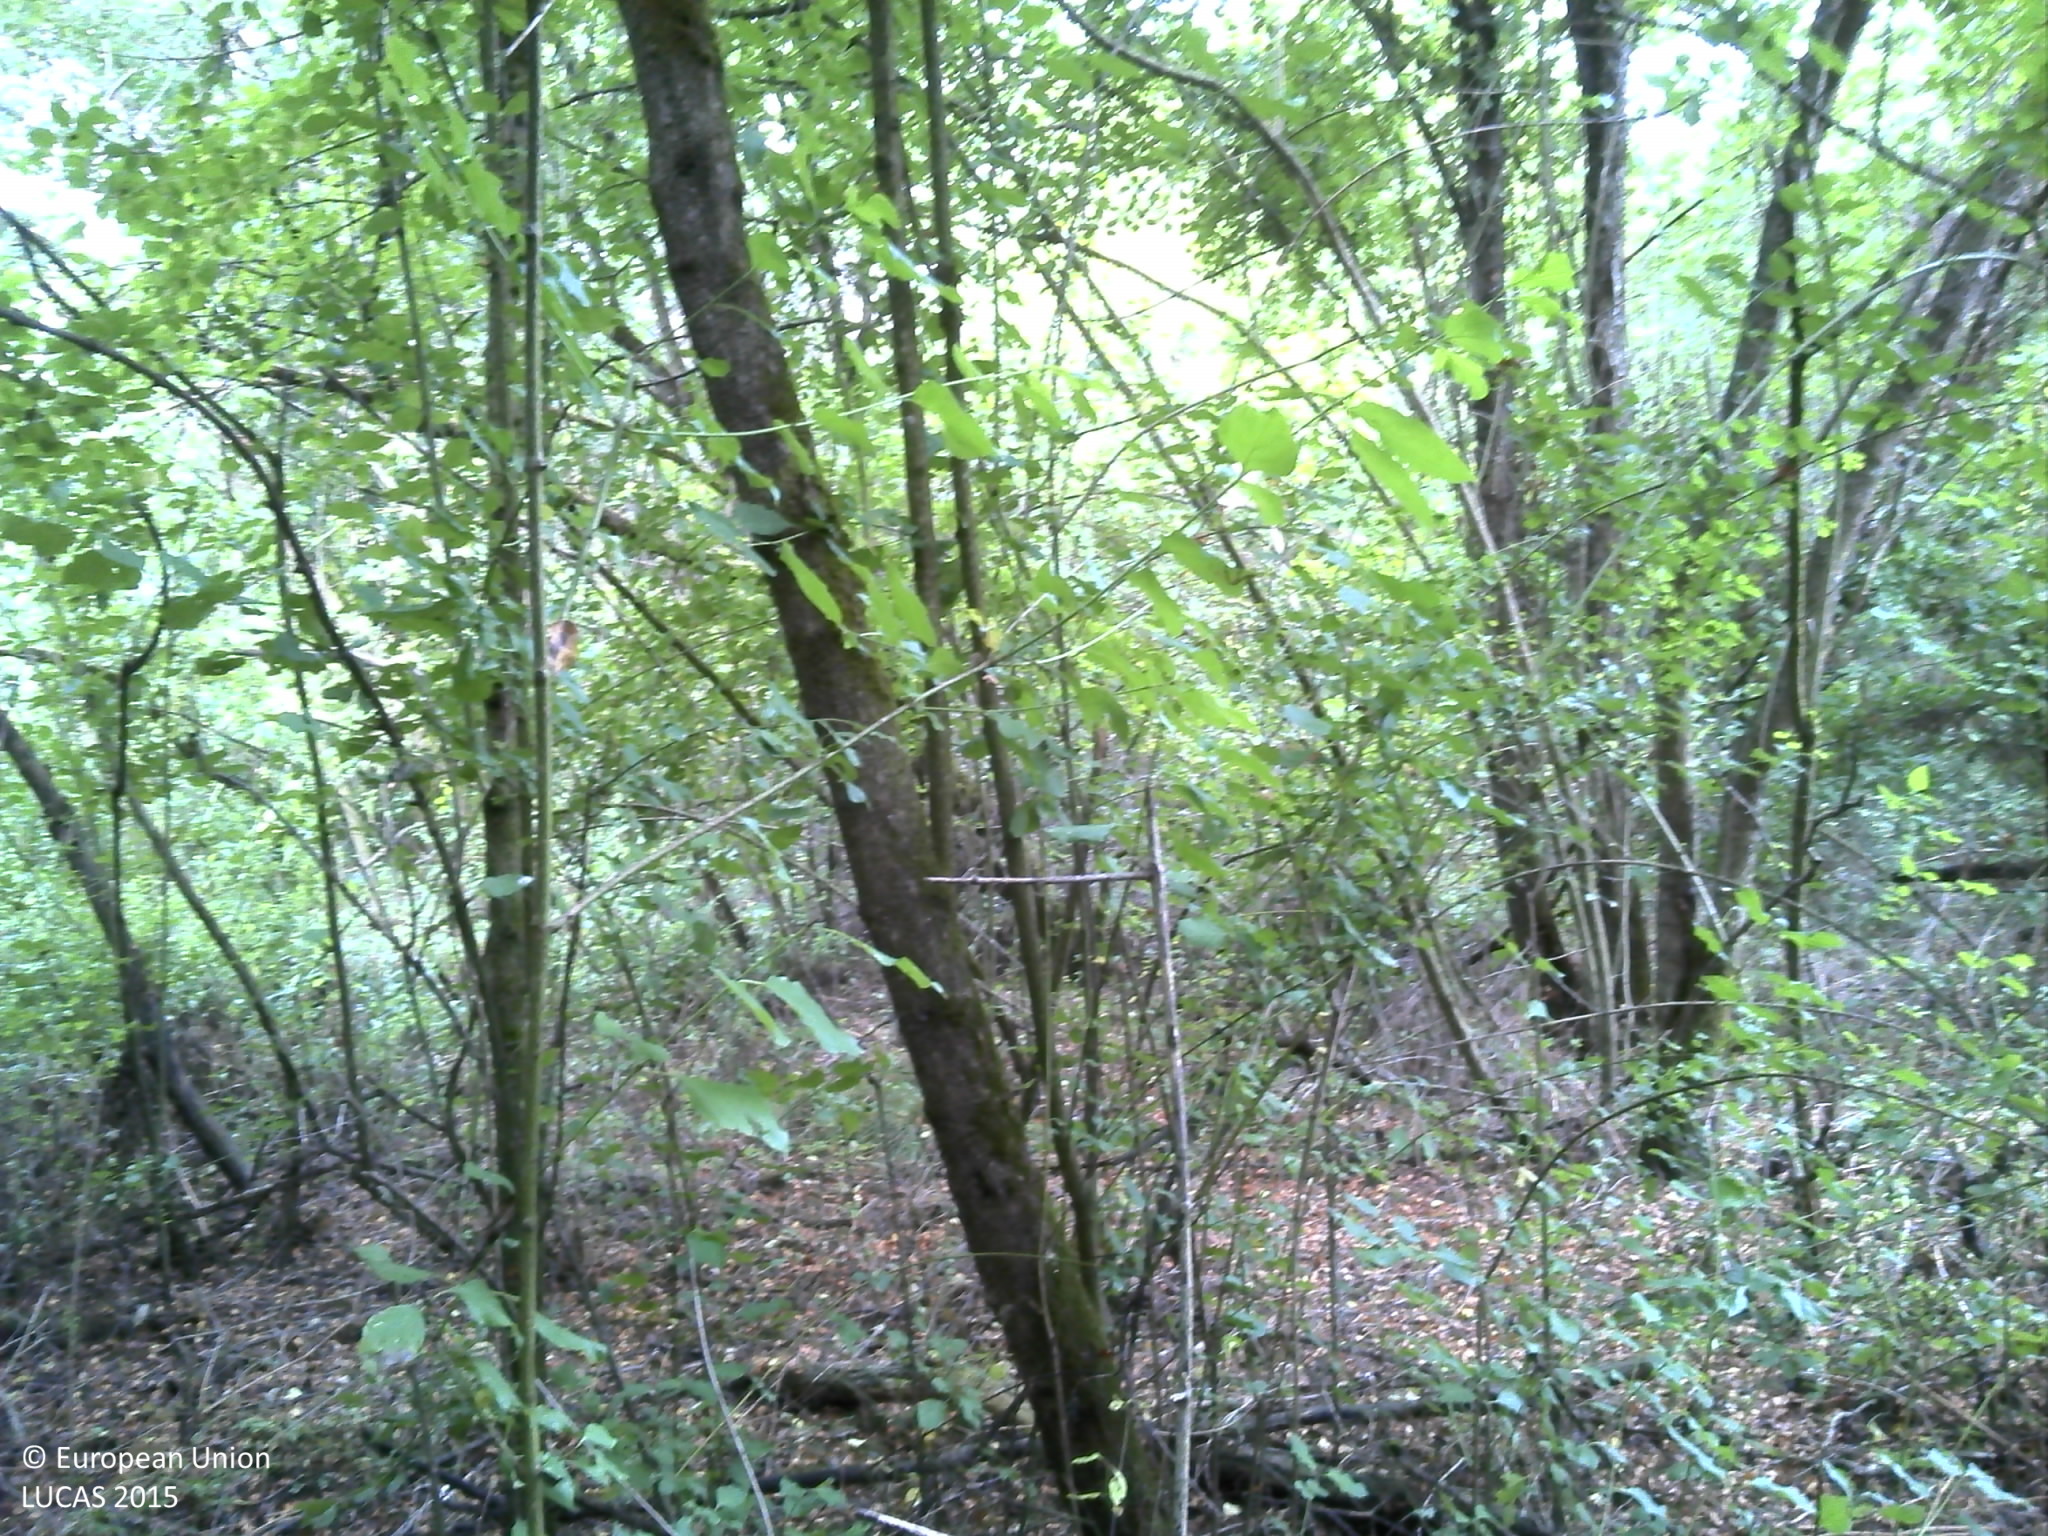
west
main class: Woodland
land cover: Broadleaved woodland
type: acidophilous oak and oak-birch forest
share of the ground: 10 - 25 %
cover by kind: shrubs 80 %, broadleaved forest trees 20 %
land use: Forestry
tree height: > 5 m
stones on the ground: < 10 %
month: August
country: HR
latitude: 45.3430
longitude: 18.0307
